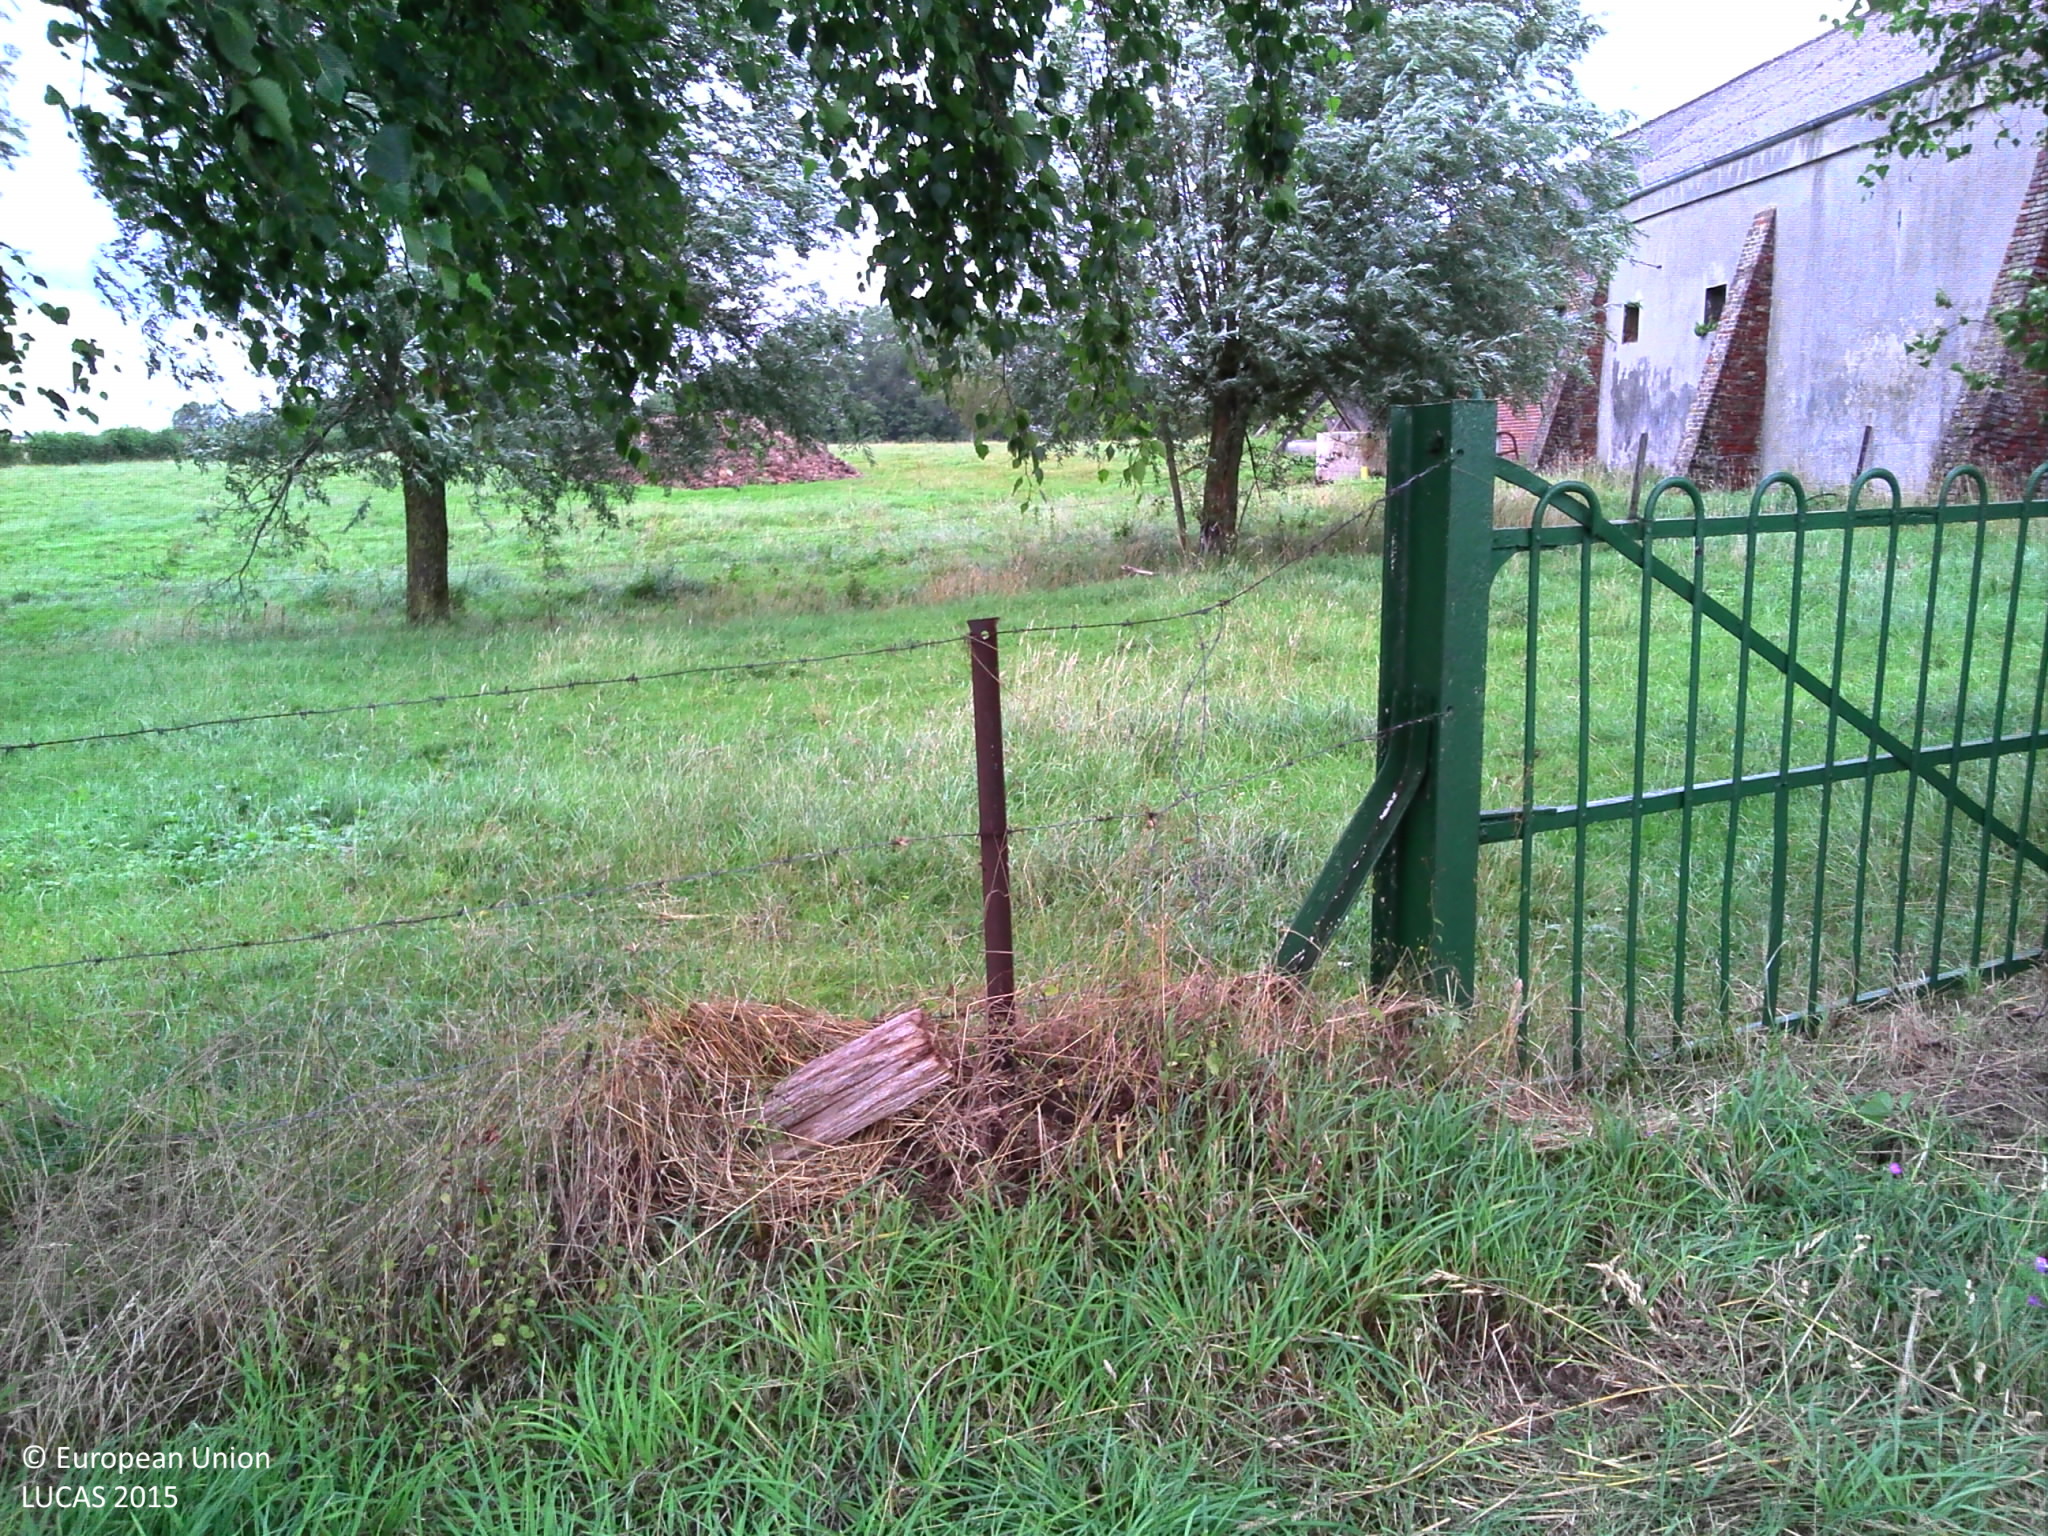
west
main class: Grassland
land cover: Grassland without tree/shrub cover
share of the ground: > 75 %
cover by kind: herbaceous plants 95 %, lichens and mosses 5 %
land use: Agriculture (excluding fallow land and kitchen gardens)
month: July
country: FR
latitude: 50.1681
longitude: 3.6229
